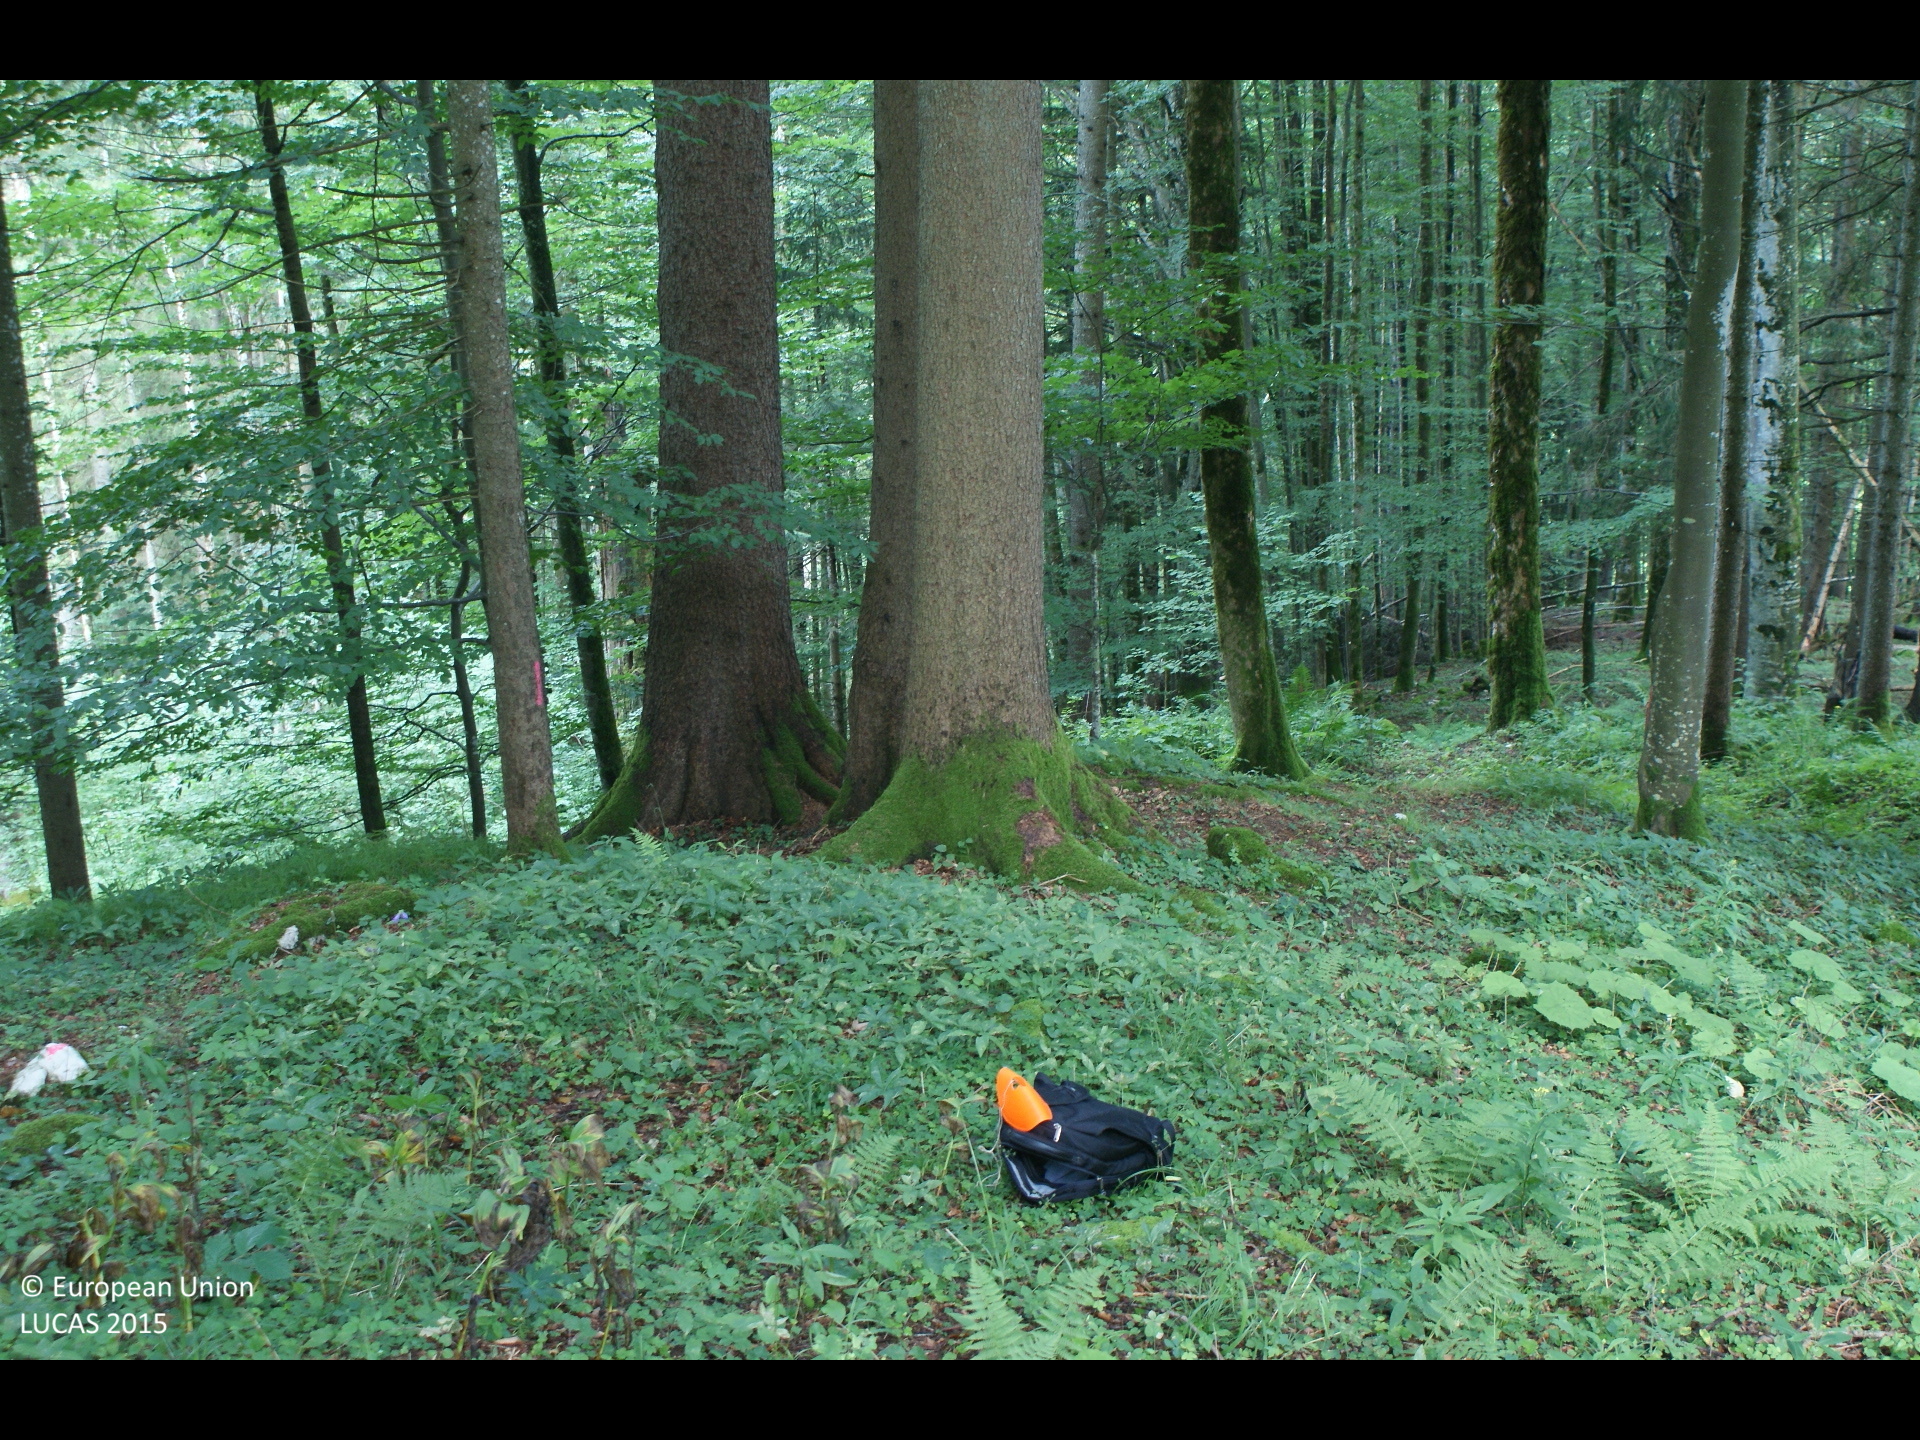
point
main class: Woodland
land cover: Spruce dominated mixed woodland
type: mountainous beech forest
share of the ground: > 75 %
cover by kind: coniferous forest trees 60 %, broadleaved forest trees 30 %, herbaceous plants 10 %
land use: Forestry
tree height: > 5 m
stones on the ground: < 10 %
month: July
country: AT
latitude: 47.8045
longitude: 14.9809
